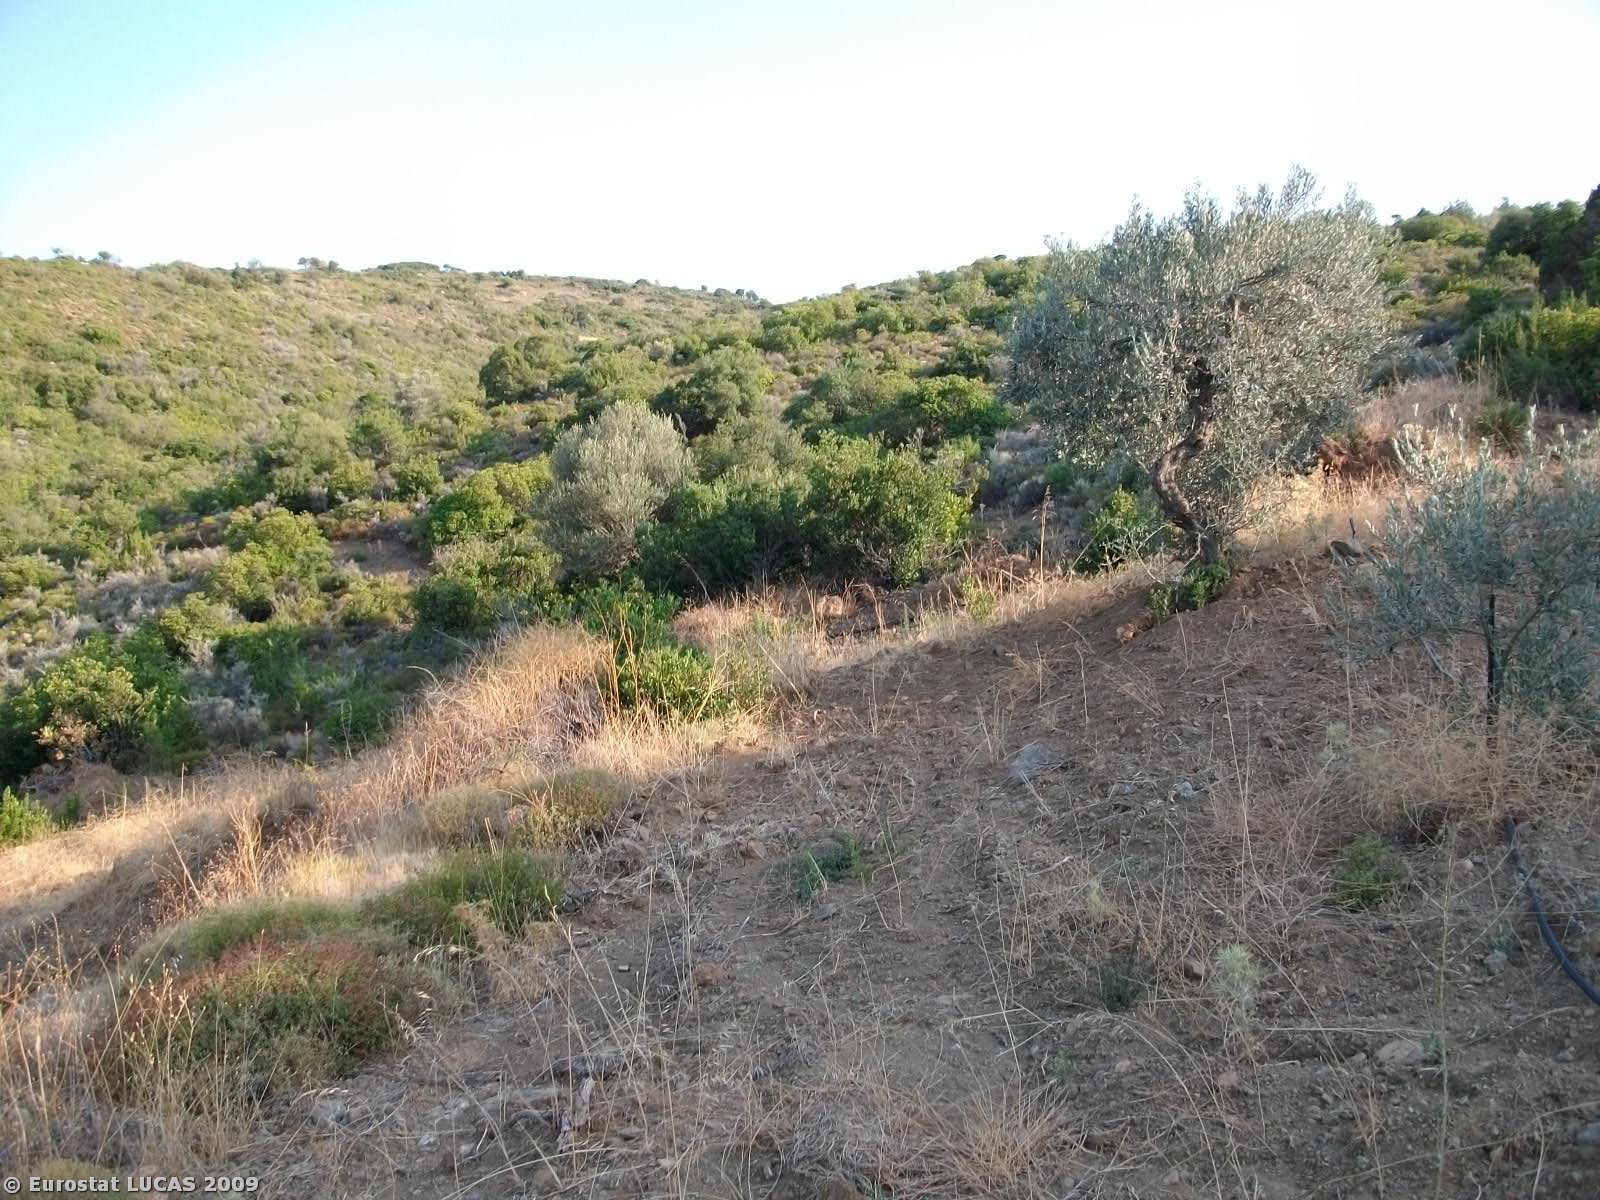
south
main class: Cropland
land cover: Olive groves
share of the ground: 10 - 25 %
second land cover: Bare land
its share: > 75 %
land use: Agriculture (excluding fallow land and kitchen gardens)
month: August
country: GR
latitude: 37.4338
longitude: 23.2924
